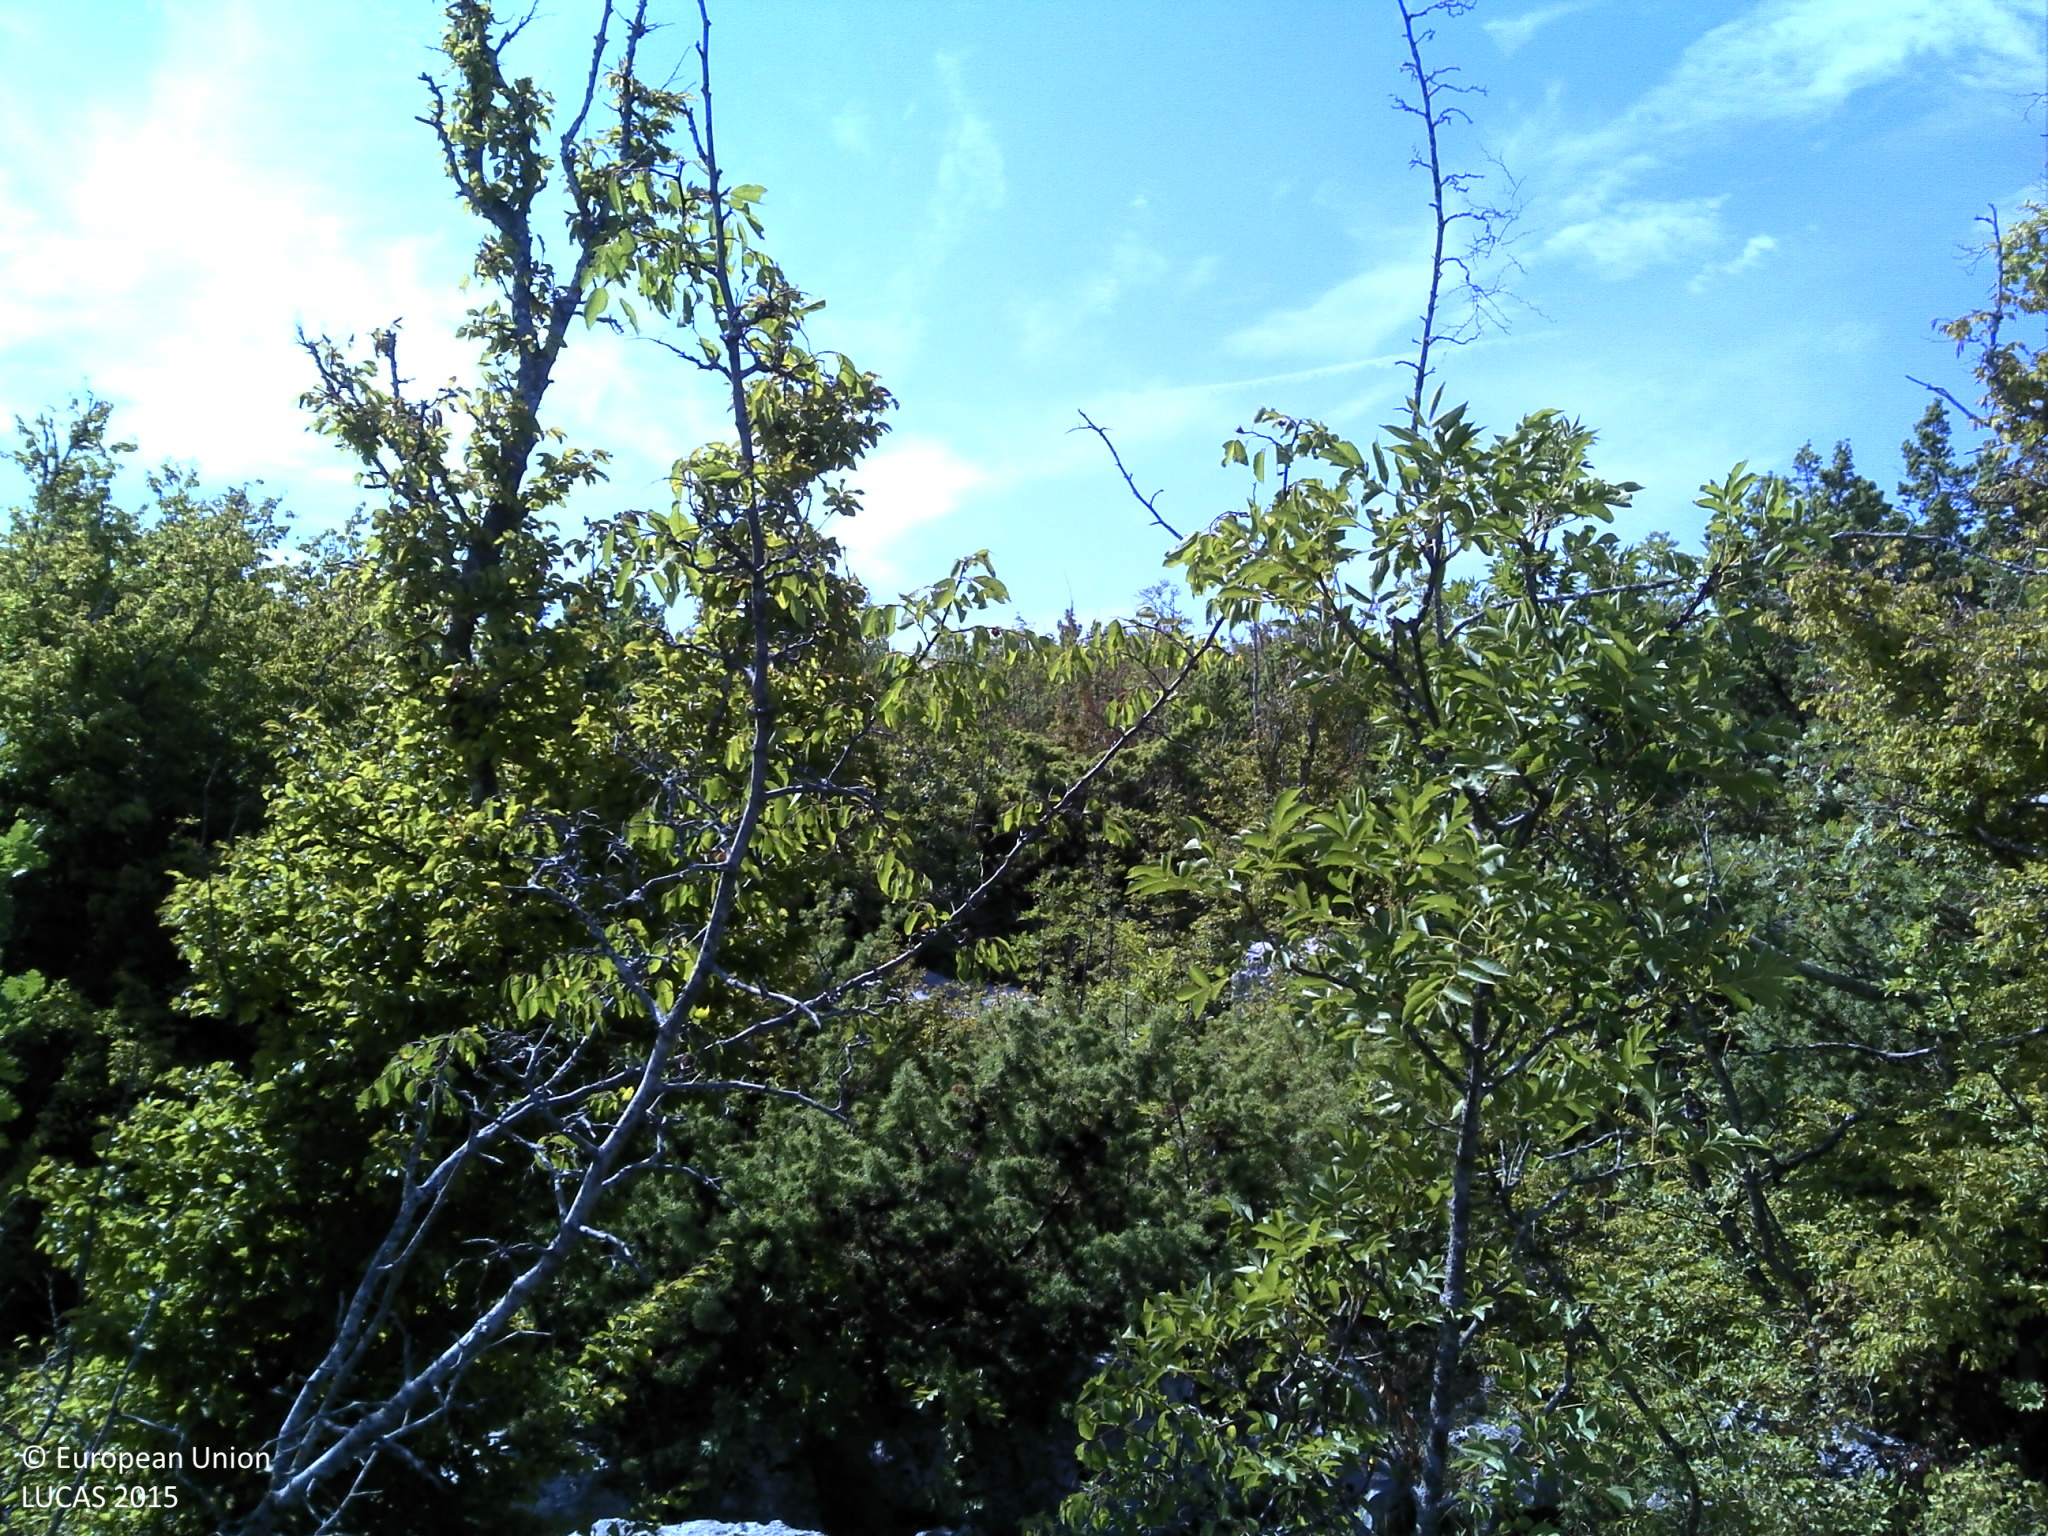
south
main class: Shrubland
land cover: Shrubland with sparse tree cover
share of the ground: > 75 %
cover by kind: shrubs 75 %, consolidated bare surface 10 %, unconsolidated bare surface 10 %, broadleaved forest trees 5 %
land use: Semi-natural and natural areas not in use
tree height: > 5 m
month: August
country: HR
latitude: 44.0038
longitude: 15.8661
